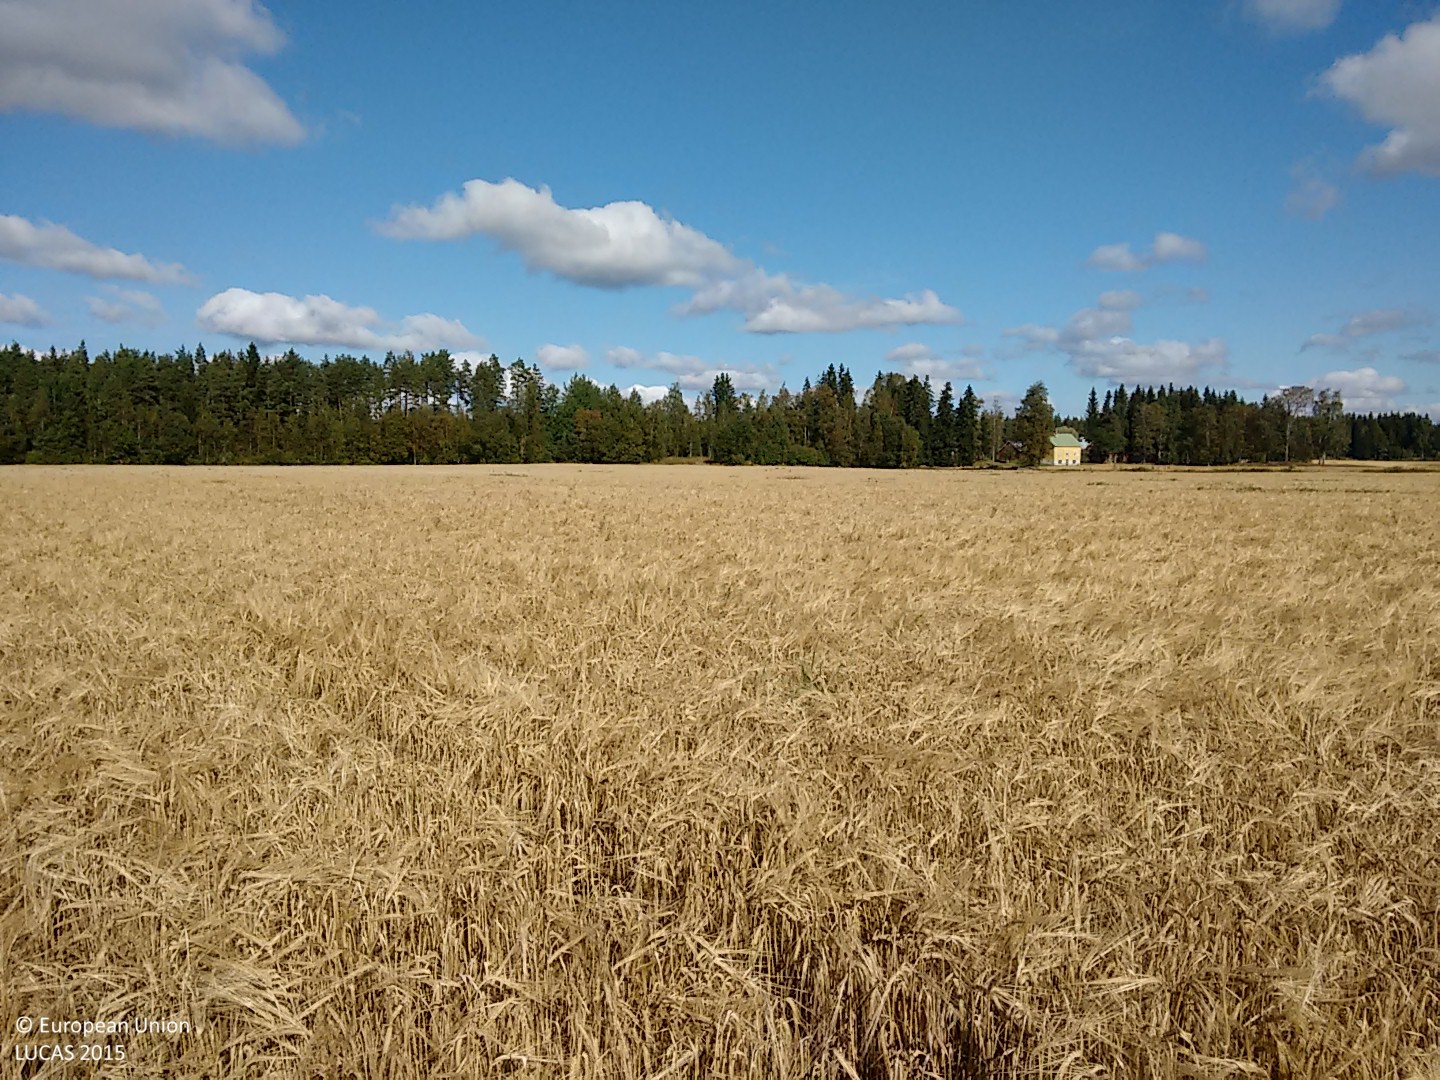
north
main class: Cropland
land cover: Barley
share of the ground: > 75 %
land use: Agriculture (excluding fallow land and kitchen gardens)
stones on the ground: < 10 %
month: September
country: FI
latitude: 60.8697
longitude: 21.7887
